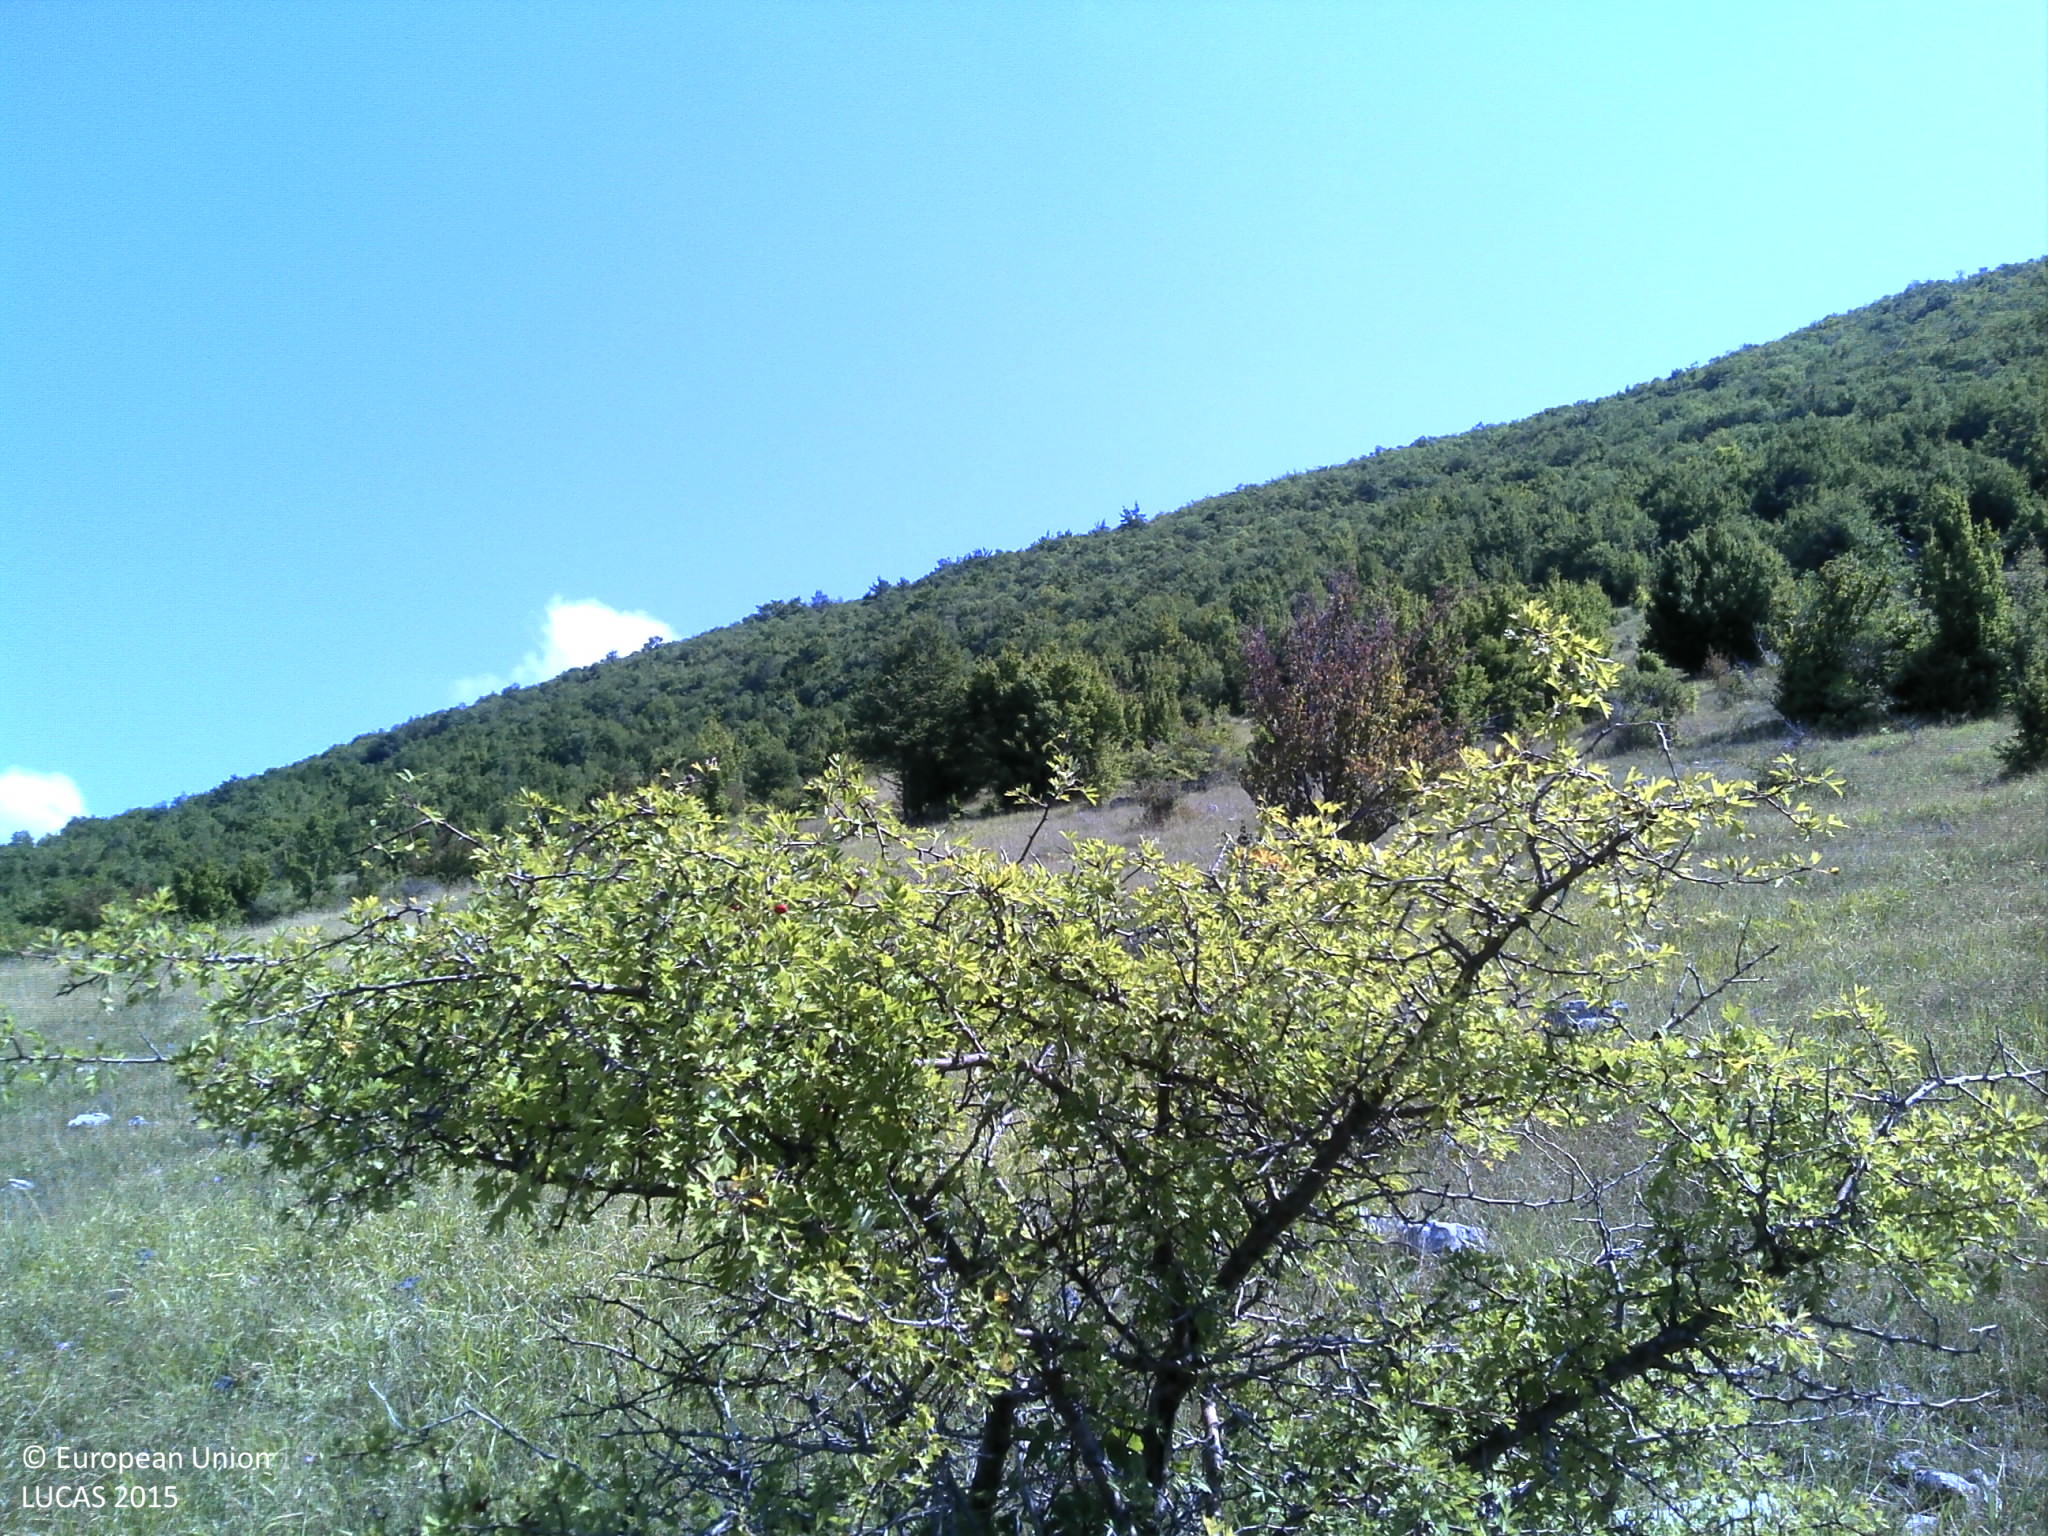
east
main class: Grassland
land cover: Grassland with sparse tree/shrub cover
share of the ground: > 75 %
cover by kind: herbaceous plants 85 %, shrubs 10 %, broadleaved forest trees 5 %
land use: Abandoned areas
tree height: < 5 m
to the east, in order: Grassland with sparse tree/shrub cover; Shrubland with sparse tree cover
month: August
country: HR
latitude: 44.3288
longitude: 15.8745
